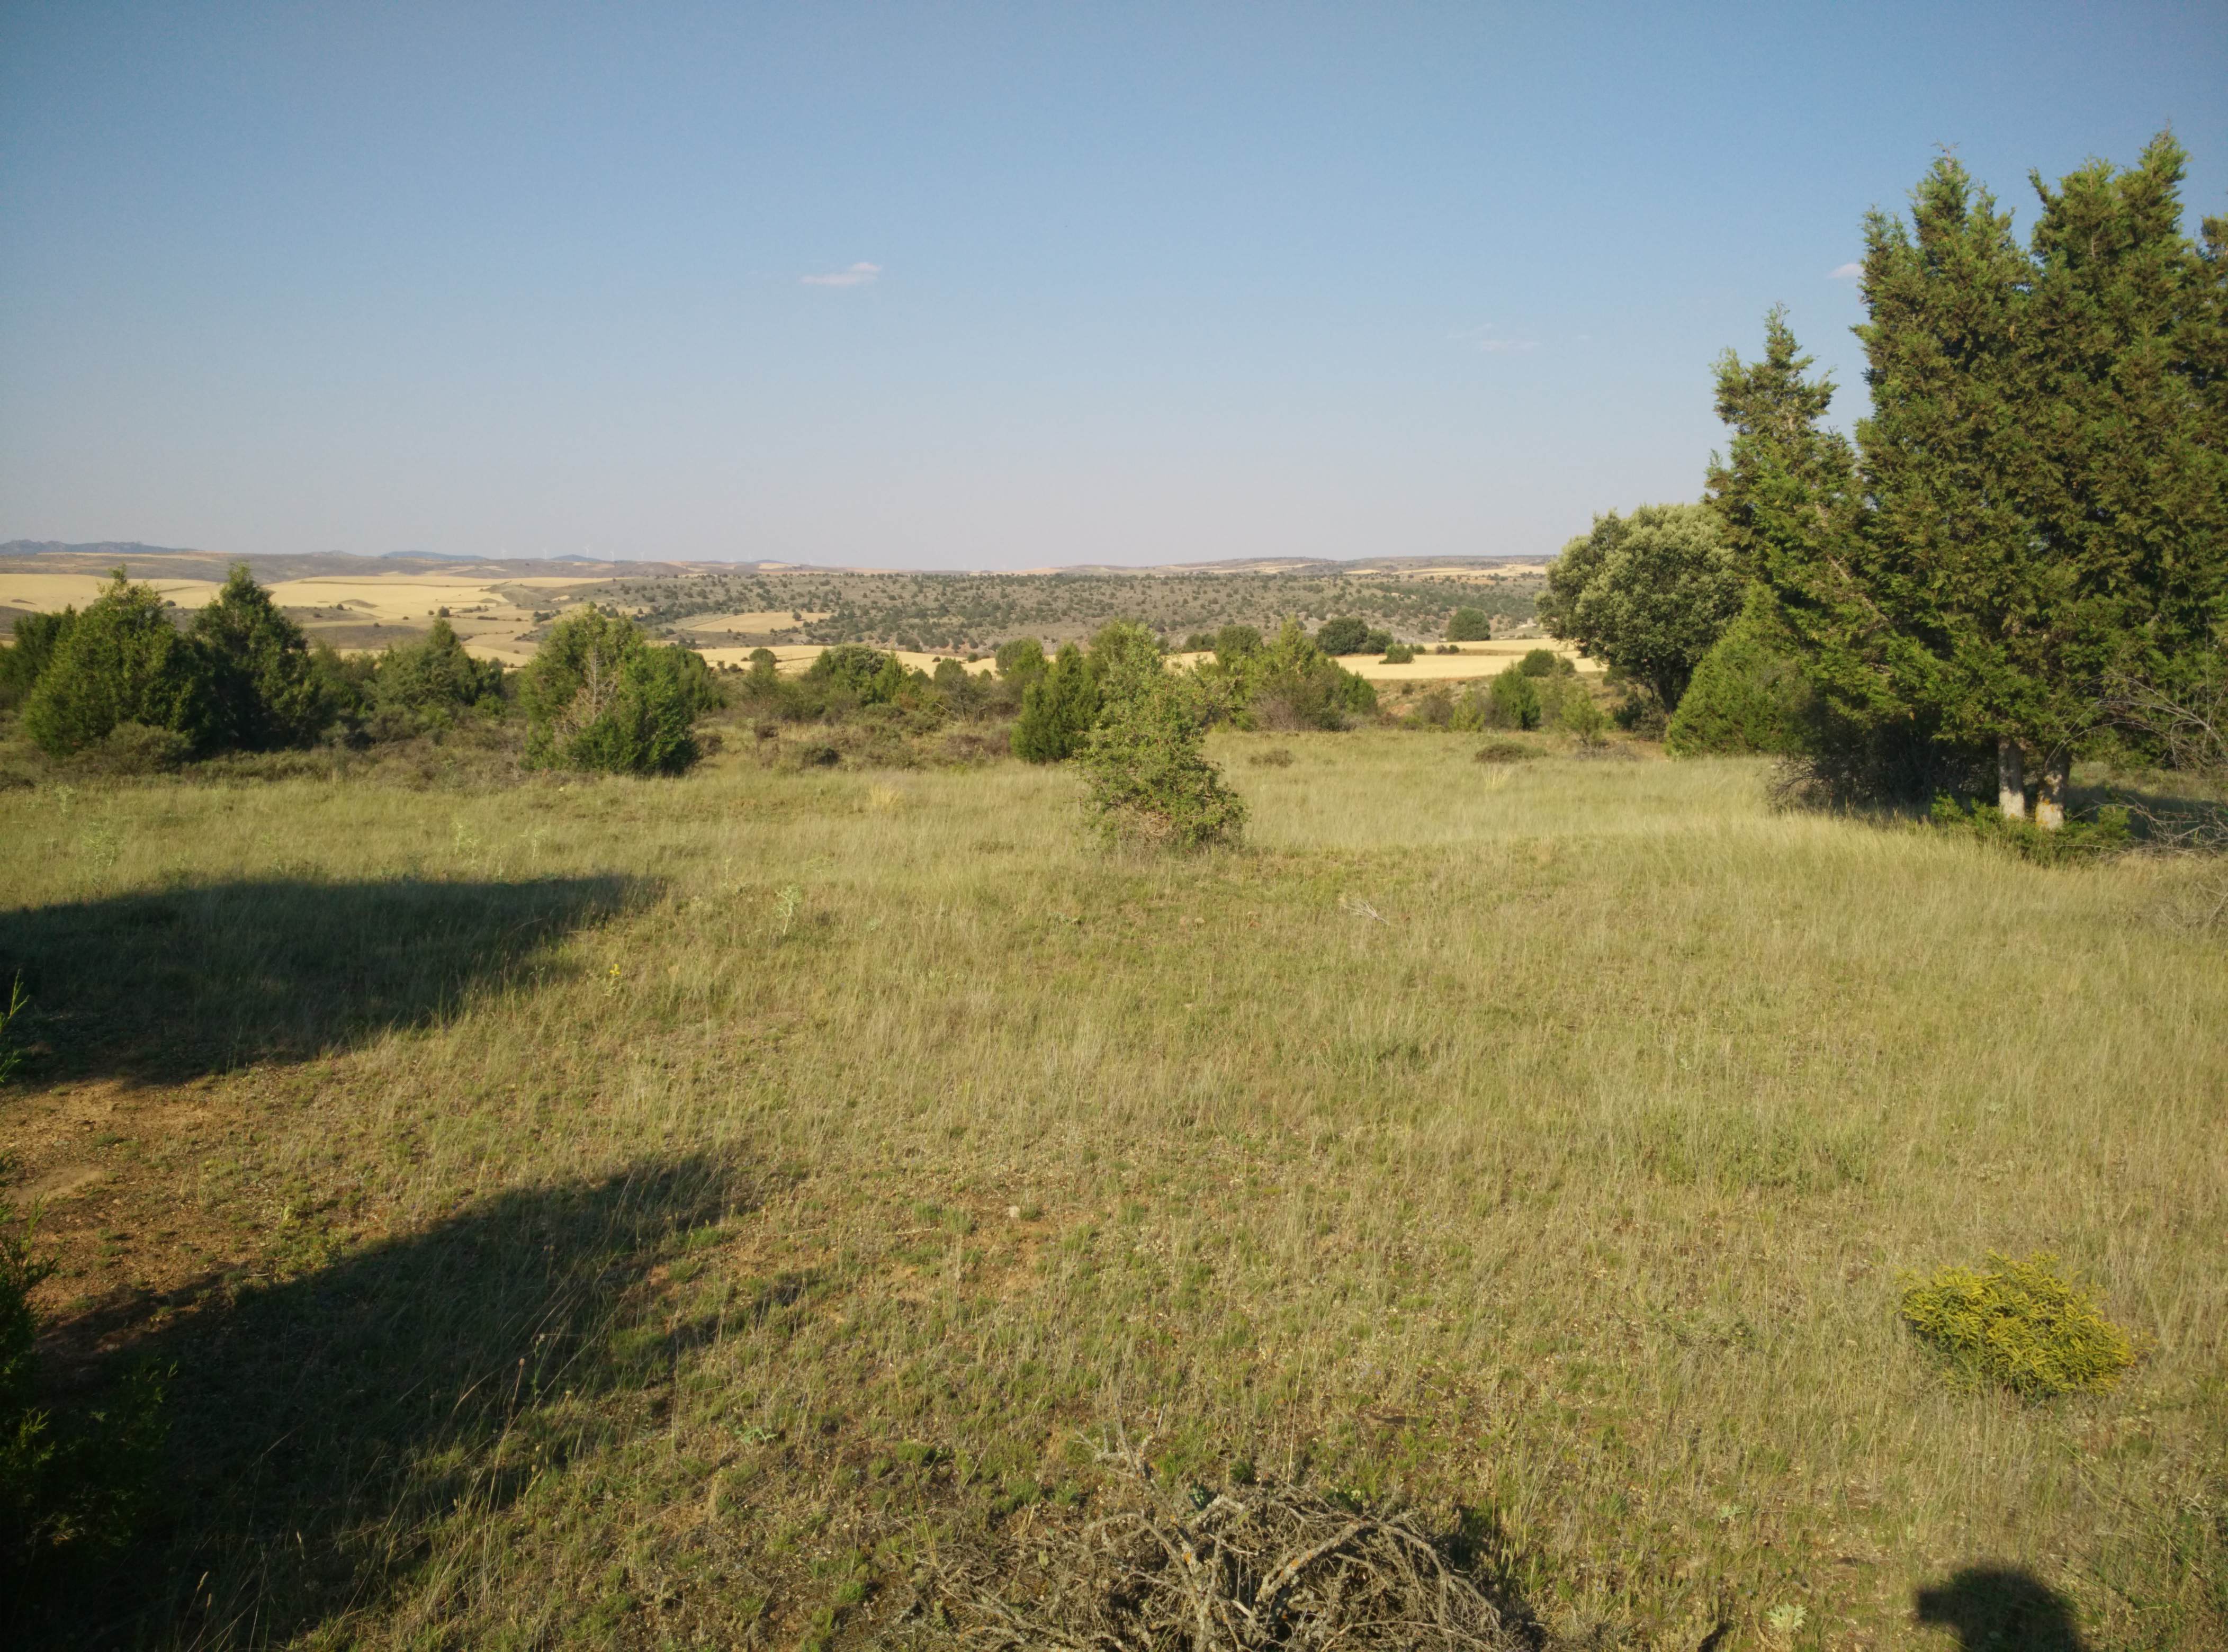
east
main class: Grassland
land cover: Grassland with sparse tree/shrub cover
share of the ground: 25 - 50 %
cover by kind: unconsolidated bare surface 50 %, herbaceous plants 40 %, broadleaved forest trees 5 %, shrubs 5 %
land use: Semi-natural and natural areas not in use
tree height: < 5 m
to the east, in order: Grassland with sparse tree/shrub cover; Shrubland with sparse tree cover; Rock outcrops; Shrubland with sparse tree cover; Rivers and streams; Shrubland with sparse tree cover
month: June
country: ES
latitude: 40.7391
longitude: -1.8030
